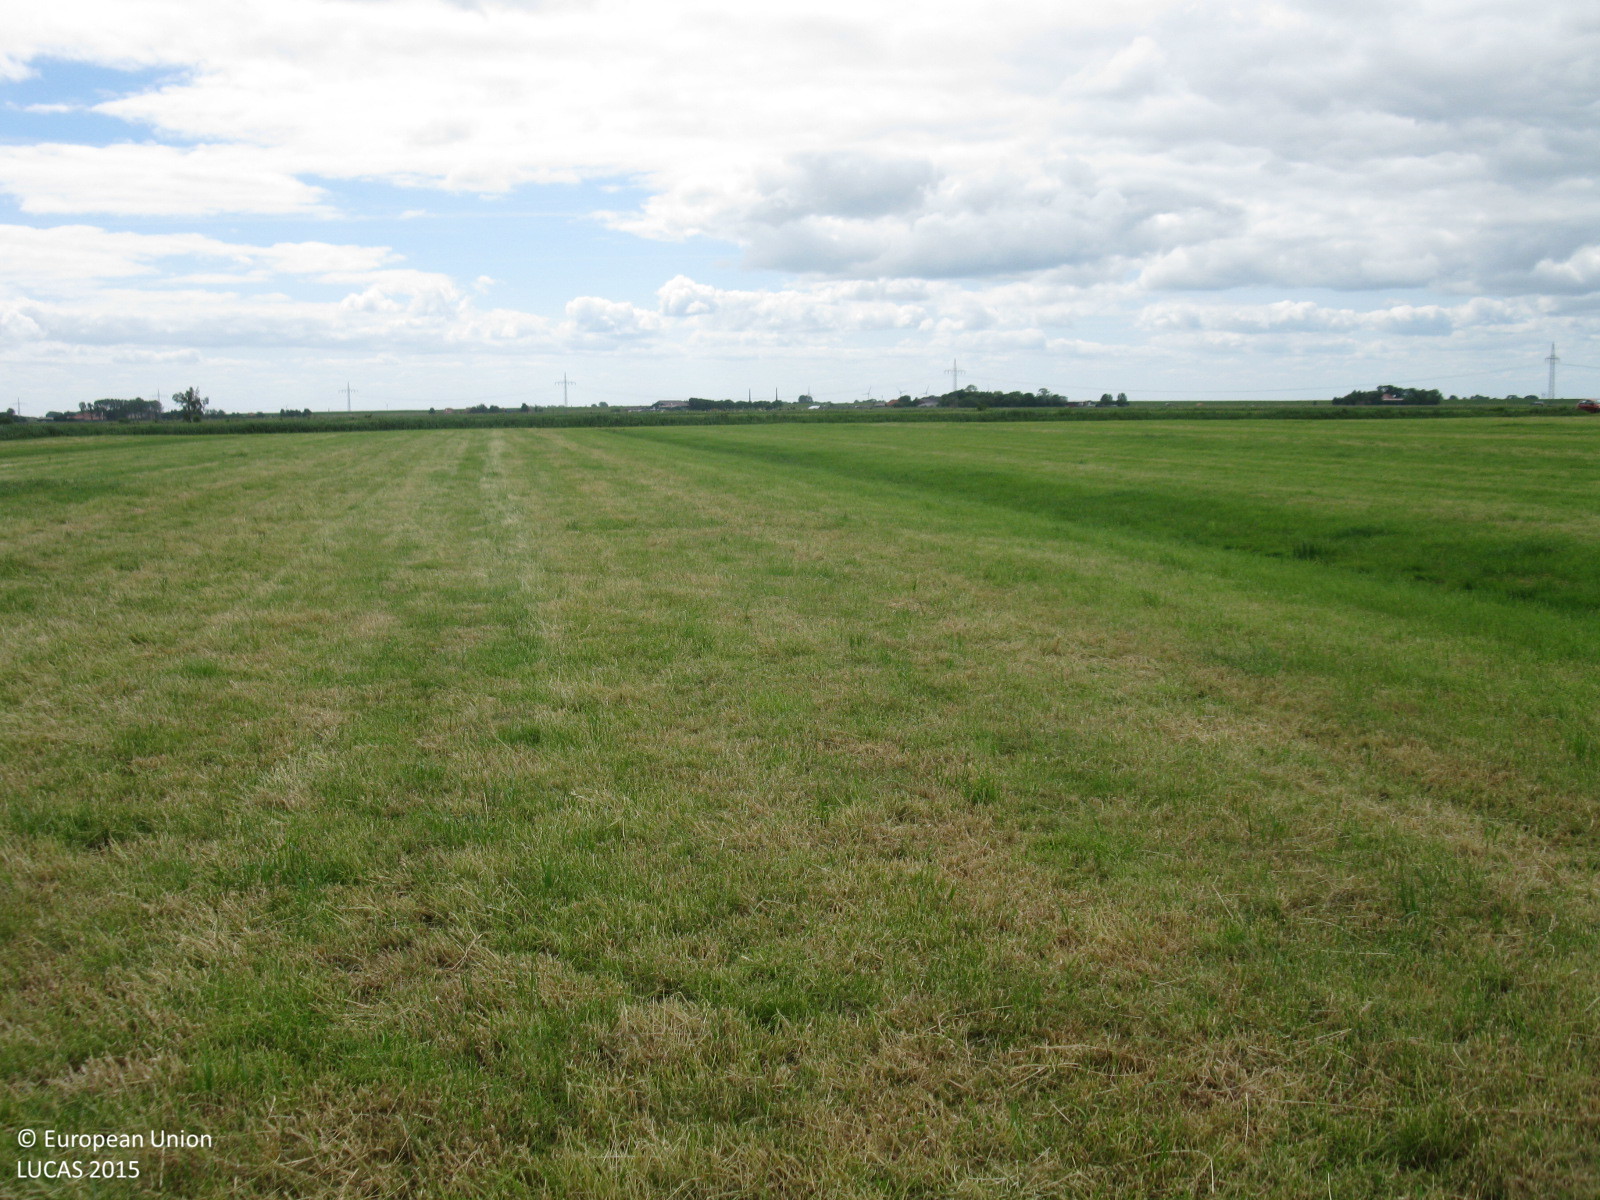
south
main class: Grassland
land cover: Grassland without tree/shrub cover
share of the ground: > 75 %
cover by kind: herbaceous plants 100 %
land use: Agriculture (excluding fallow land and kitchen gardens)
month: June
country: DE
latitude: 53.3195
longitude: 7.3735
